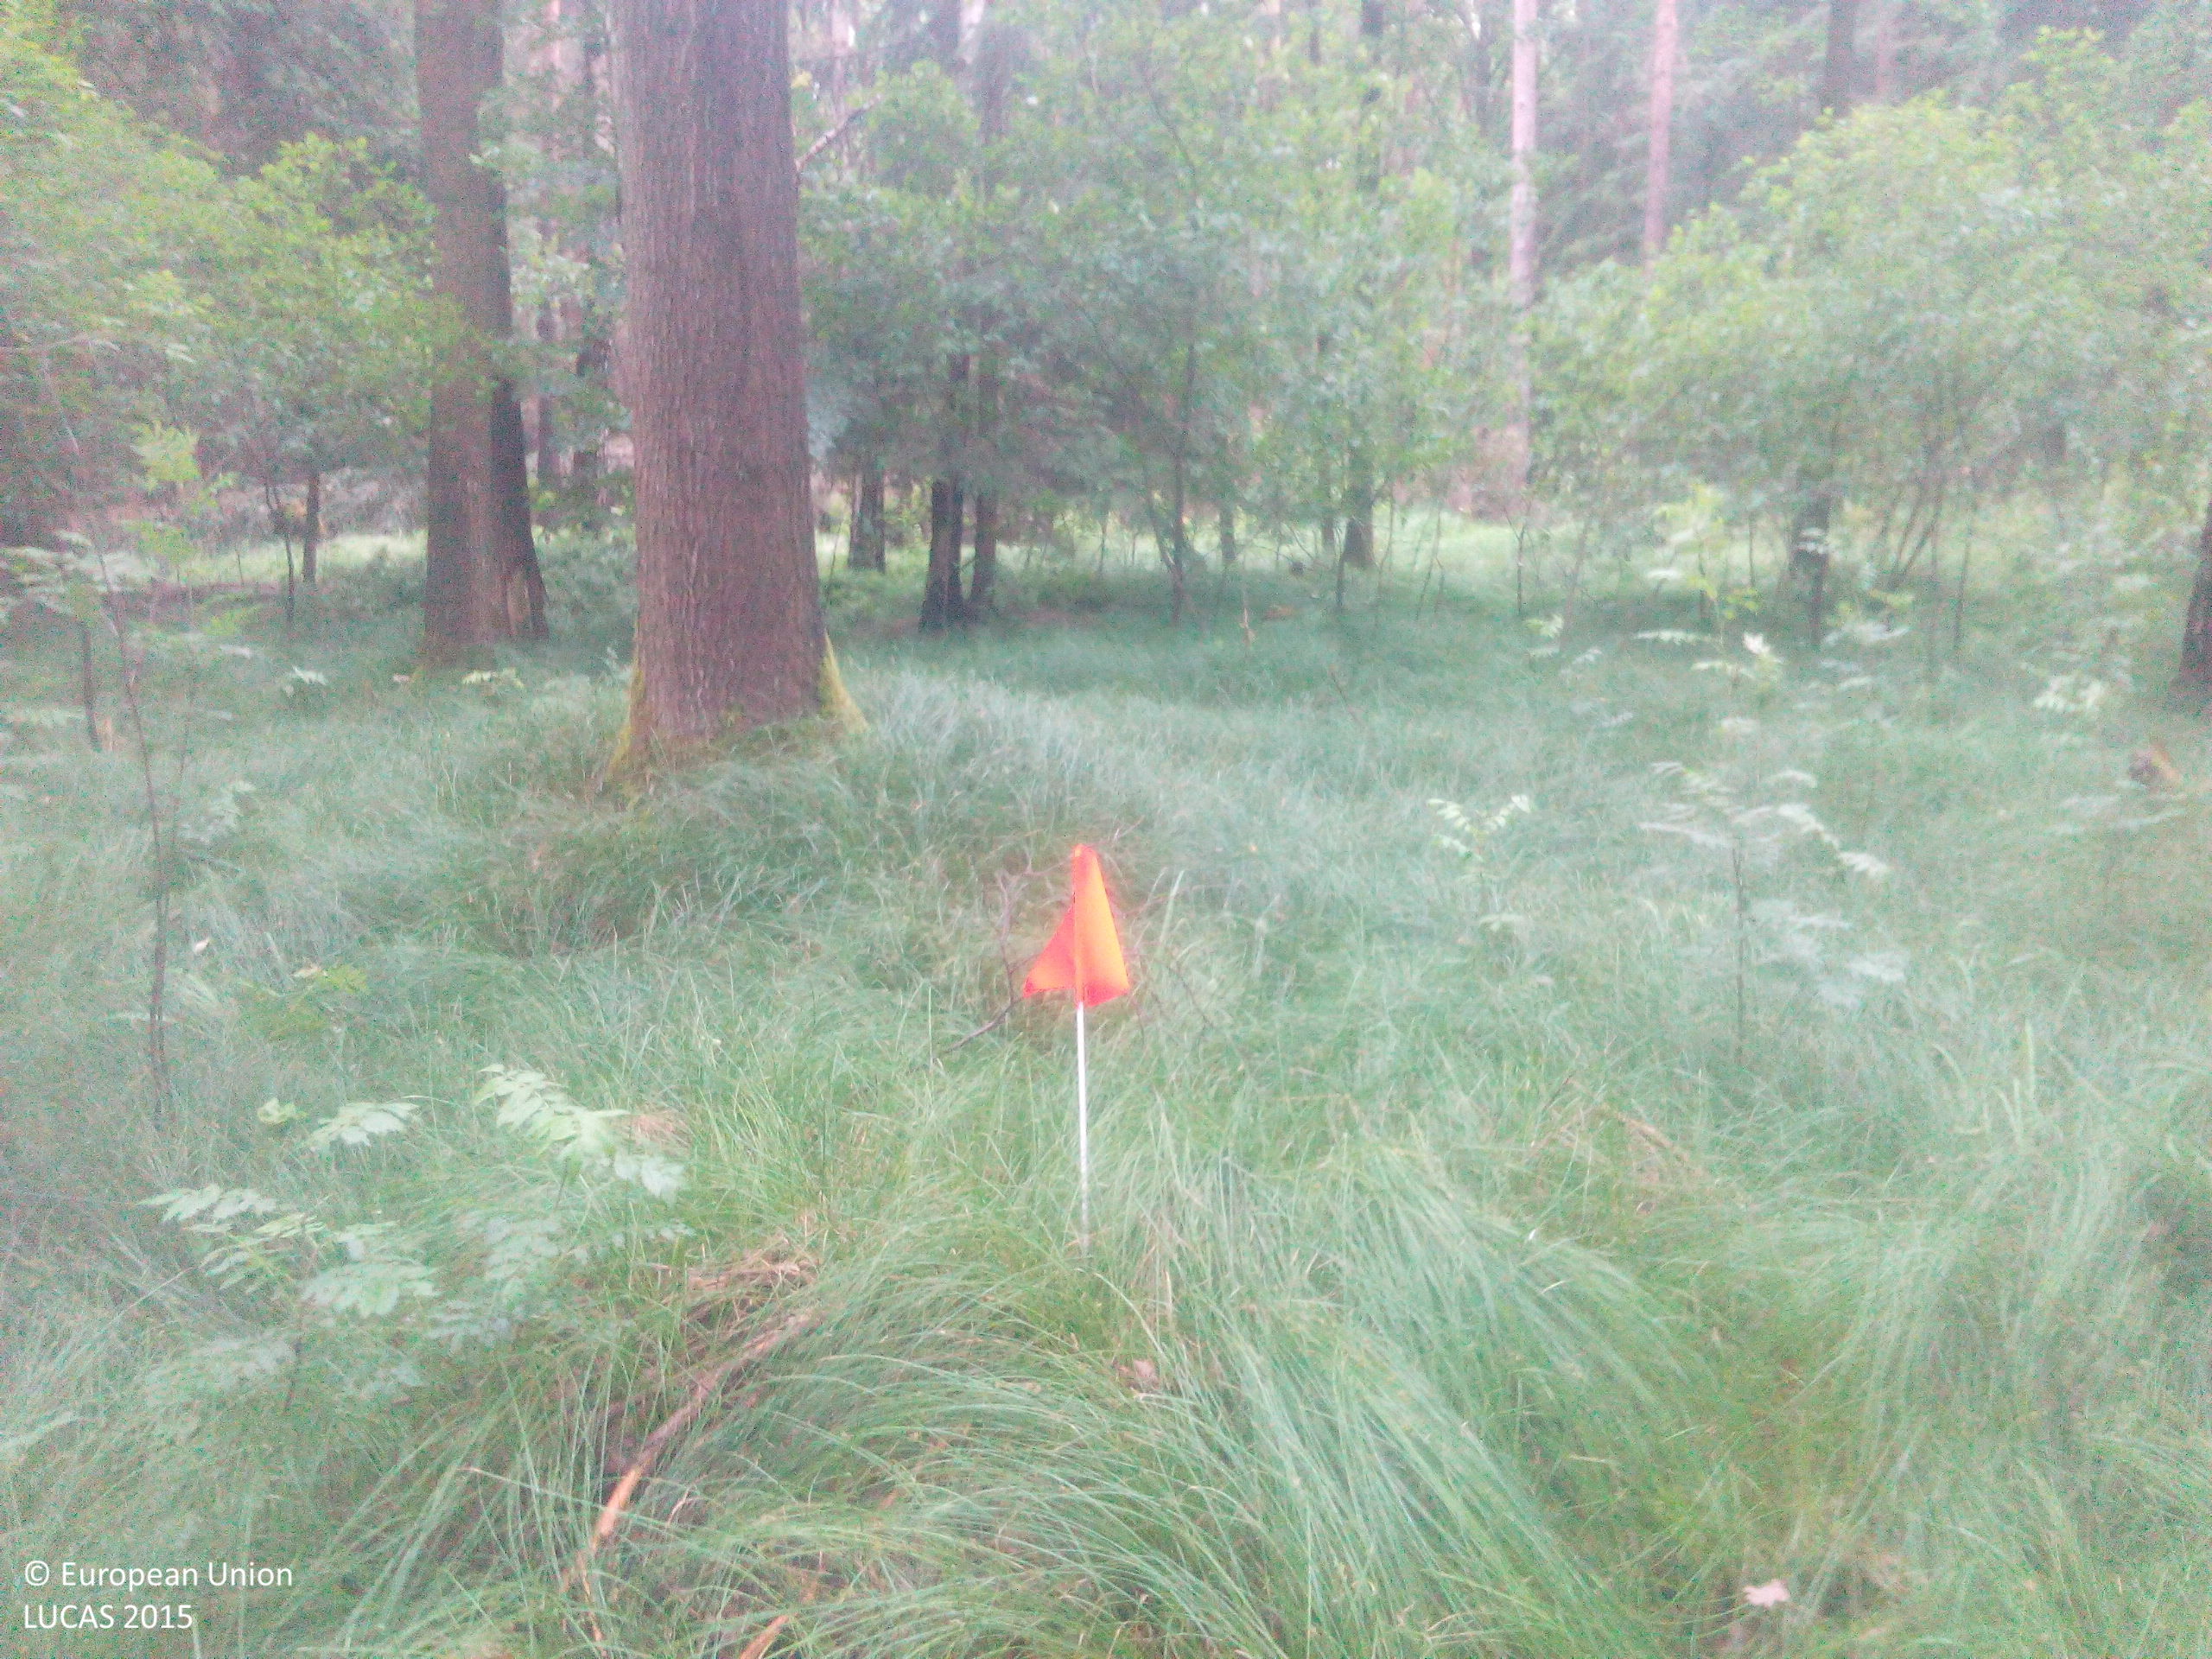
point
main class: Woodland
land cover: Spruce dominated mixed woodland
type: hemiboreal forest and nemoral coniferous forest and mixed broadleaved-coniferous forest
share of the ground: > 75 %
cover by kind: broadleaved forest trees 60 %, coniferous forest trees 25 %, herbaceous plants 15 %
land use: Forestry
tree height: > 5 m
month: June
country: DE
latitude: 51.0868
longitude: 13.9841
